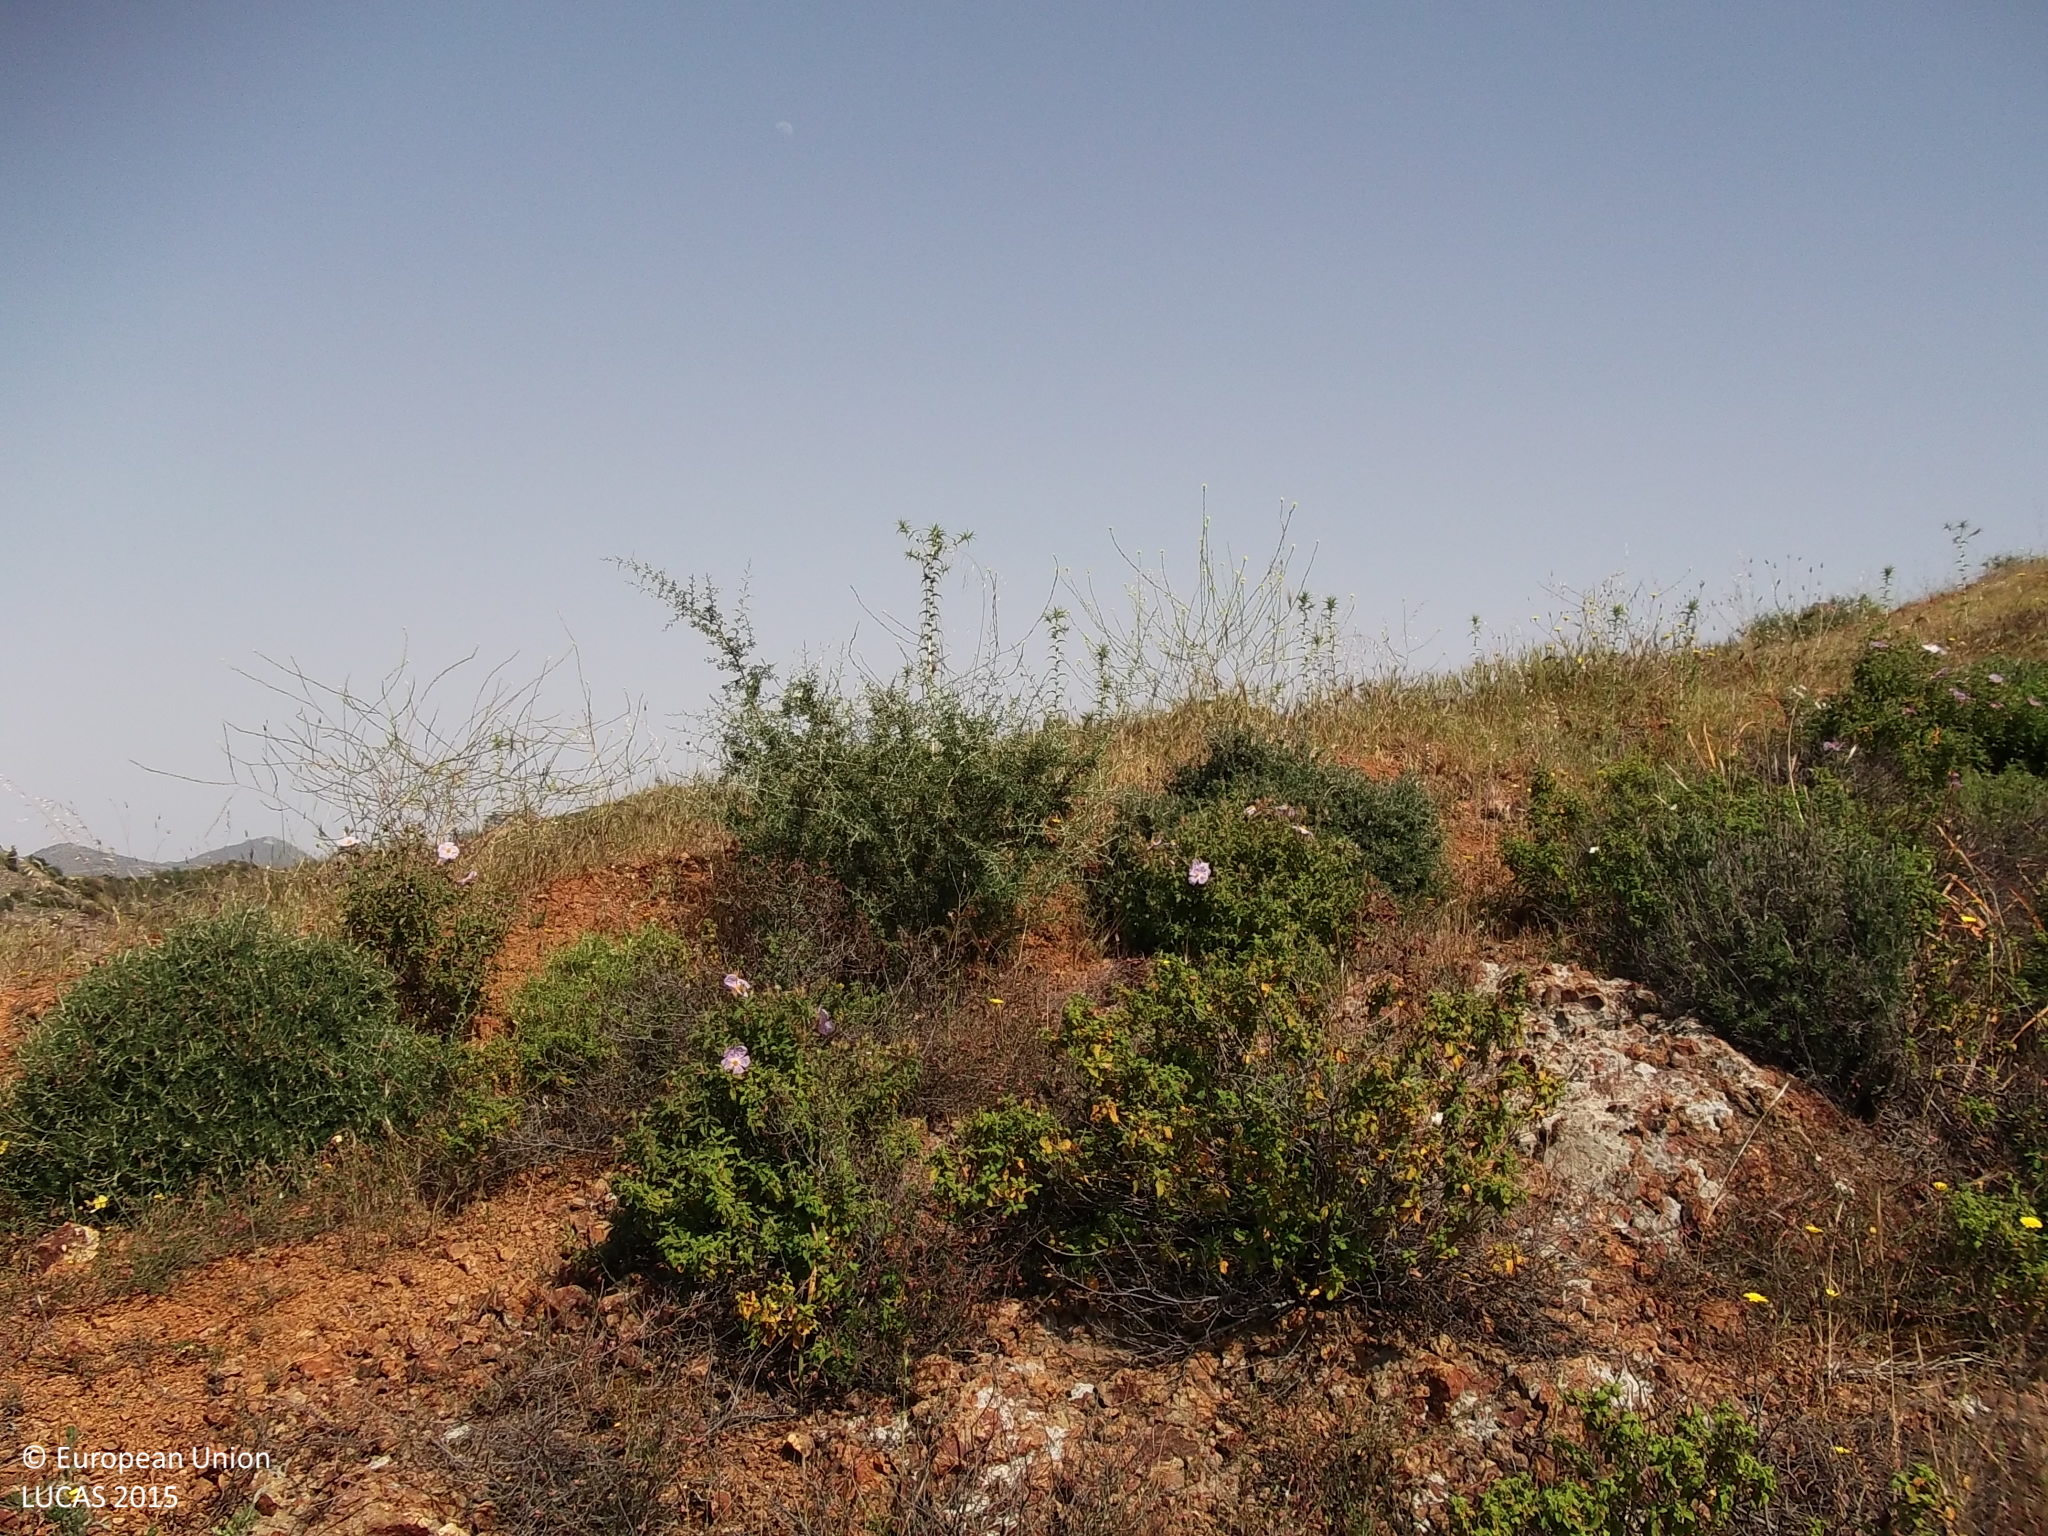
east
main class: Shrubland
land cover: Shrubland with sparse tree cover
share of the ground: > 75 %
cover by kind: shrubs 95 %, broadleaved forest trees 5 %
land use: Semi-natural and natural areas not in use
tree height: < 5 m
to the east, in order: Shrubland with sparse tree cover; Tracks; Shrubland without tree cover
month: April
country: CY
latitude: 34.8744
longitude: 33.3434
